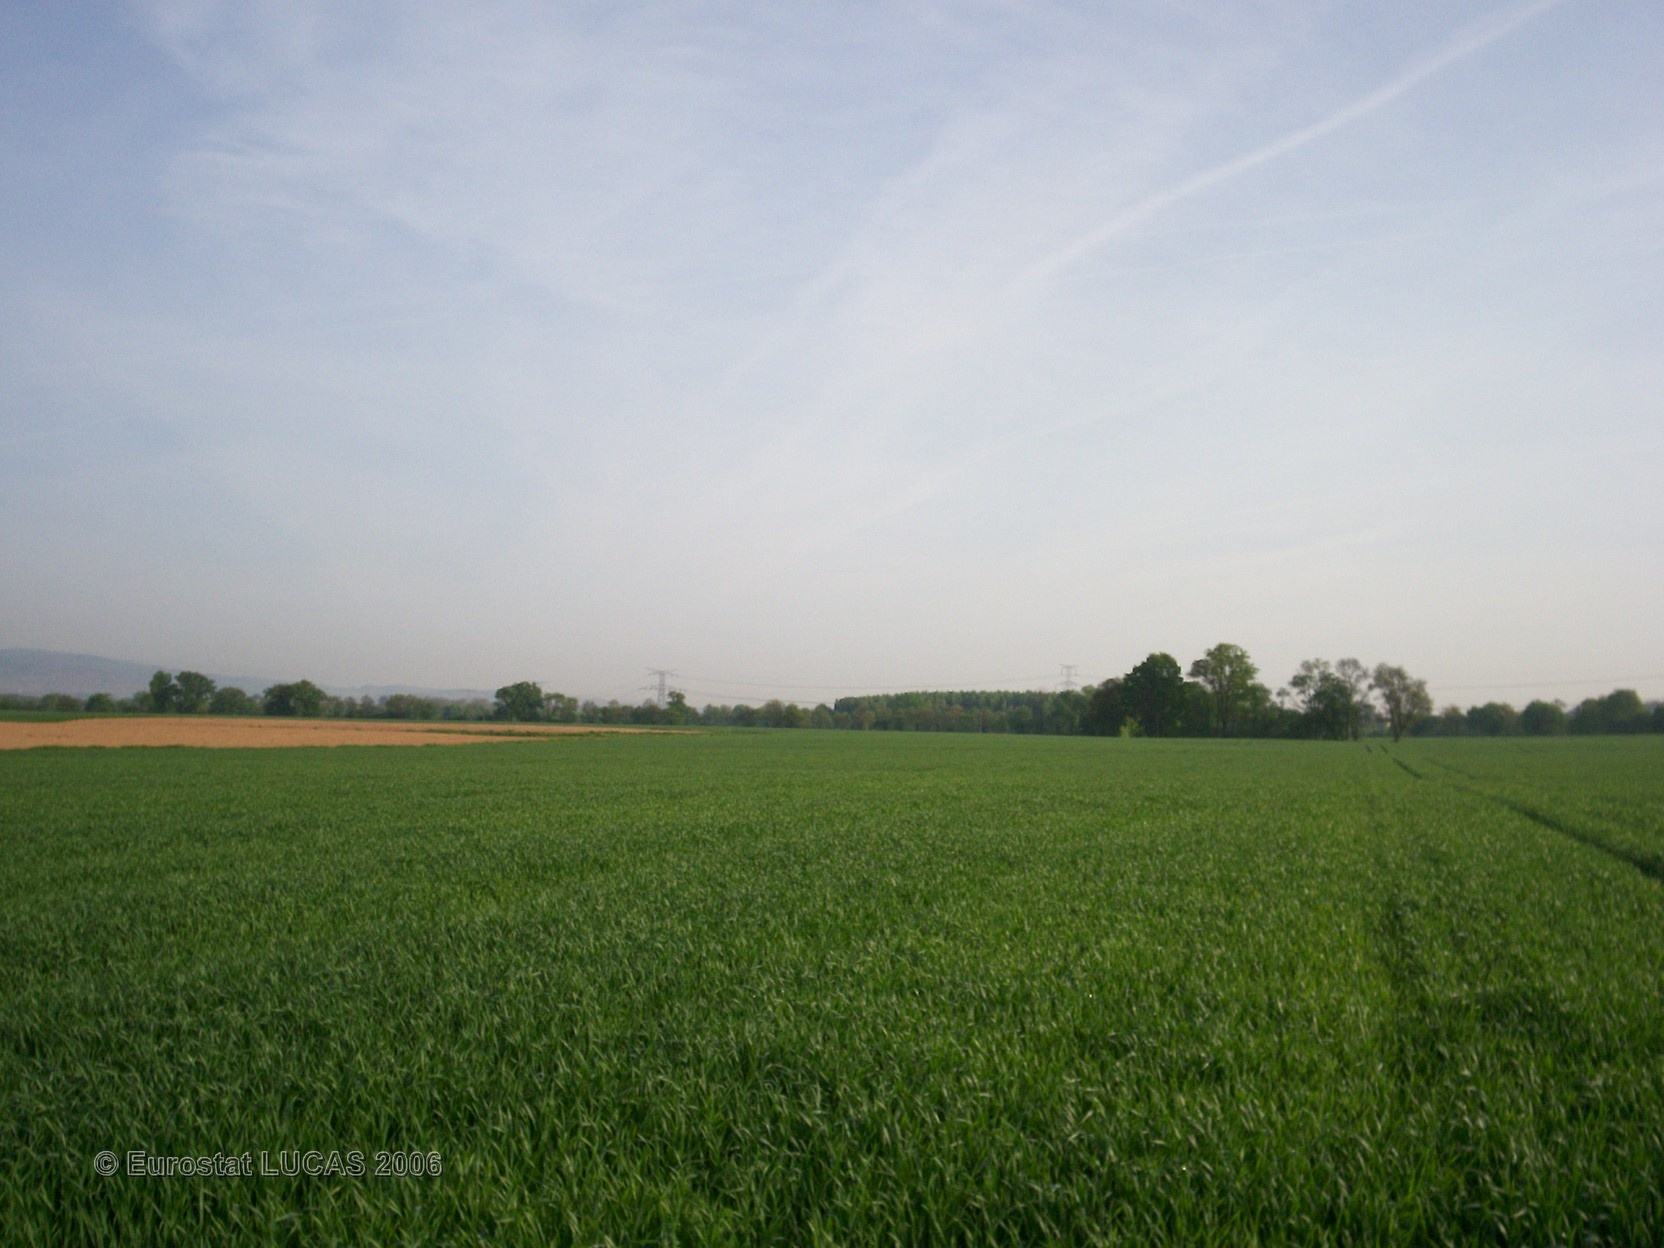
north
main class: Cropland
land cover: Common wheat
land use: Agriculture (excluding fallow land and kitchen gardens)
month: May
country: FR
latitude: 46.1518
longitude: 4.7846
